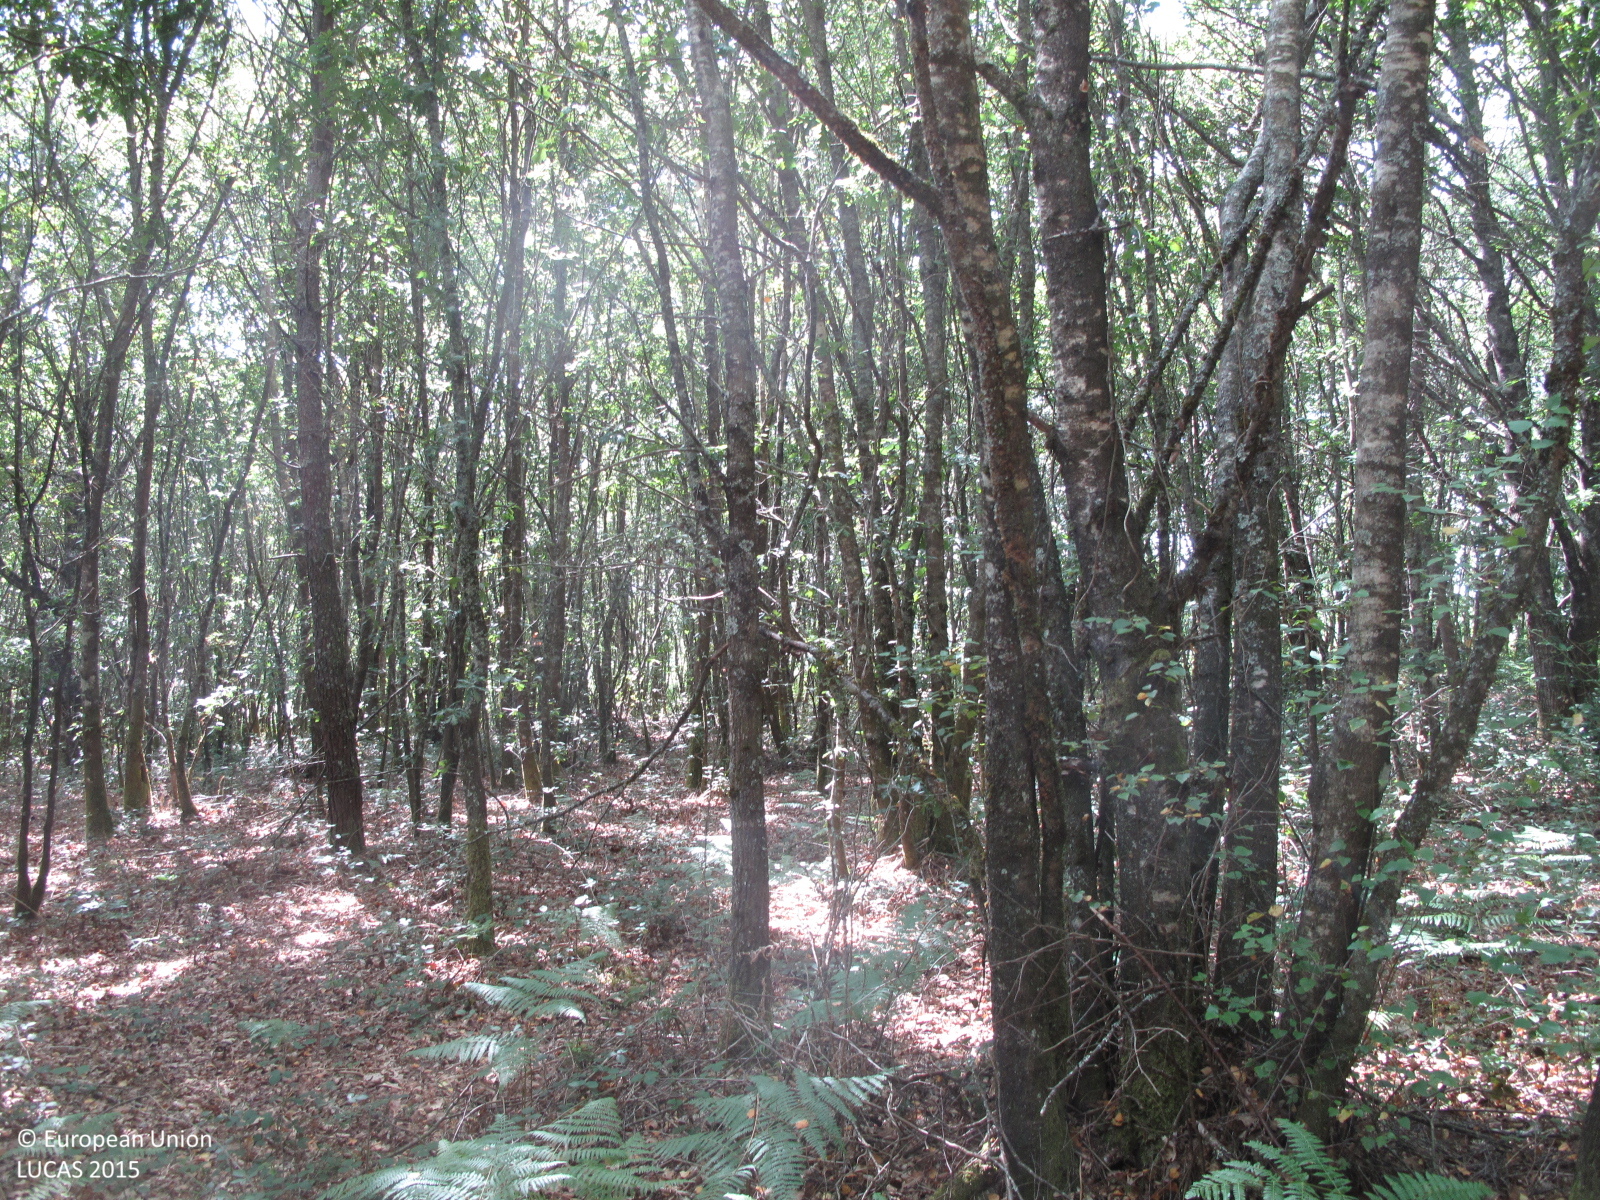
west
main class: Woodland
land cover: Broadleaved woodland
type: acidophilous oak and oak-birch forest
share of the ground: > 75 %
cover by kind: broadleaved forest trees 90 %, shrubs 5 %, herbaceous plants 5 %
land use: Semi-natural and natural areas not in use
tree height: > 5 m
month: July
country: ES
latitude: 43.0595
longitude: -8.0811
